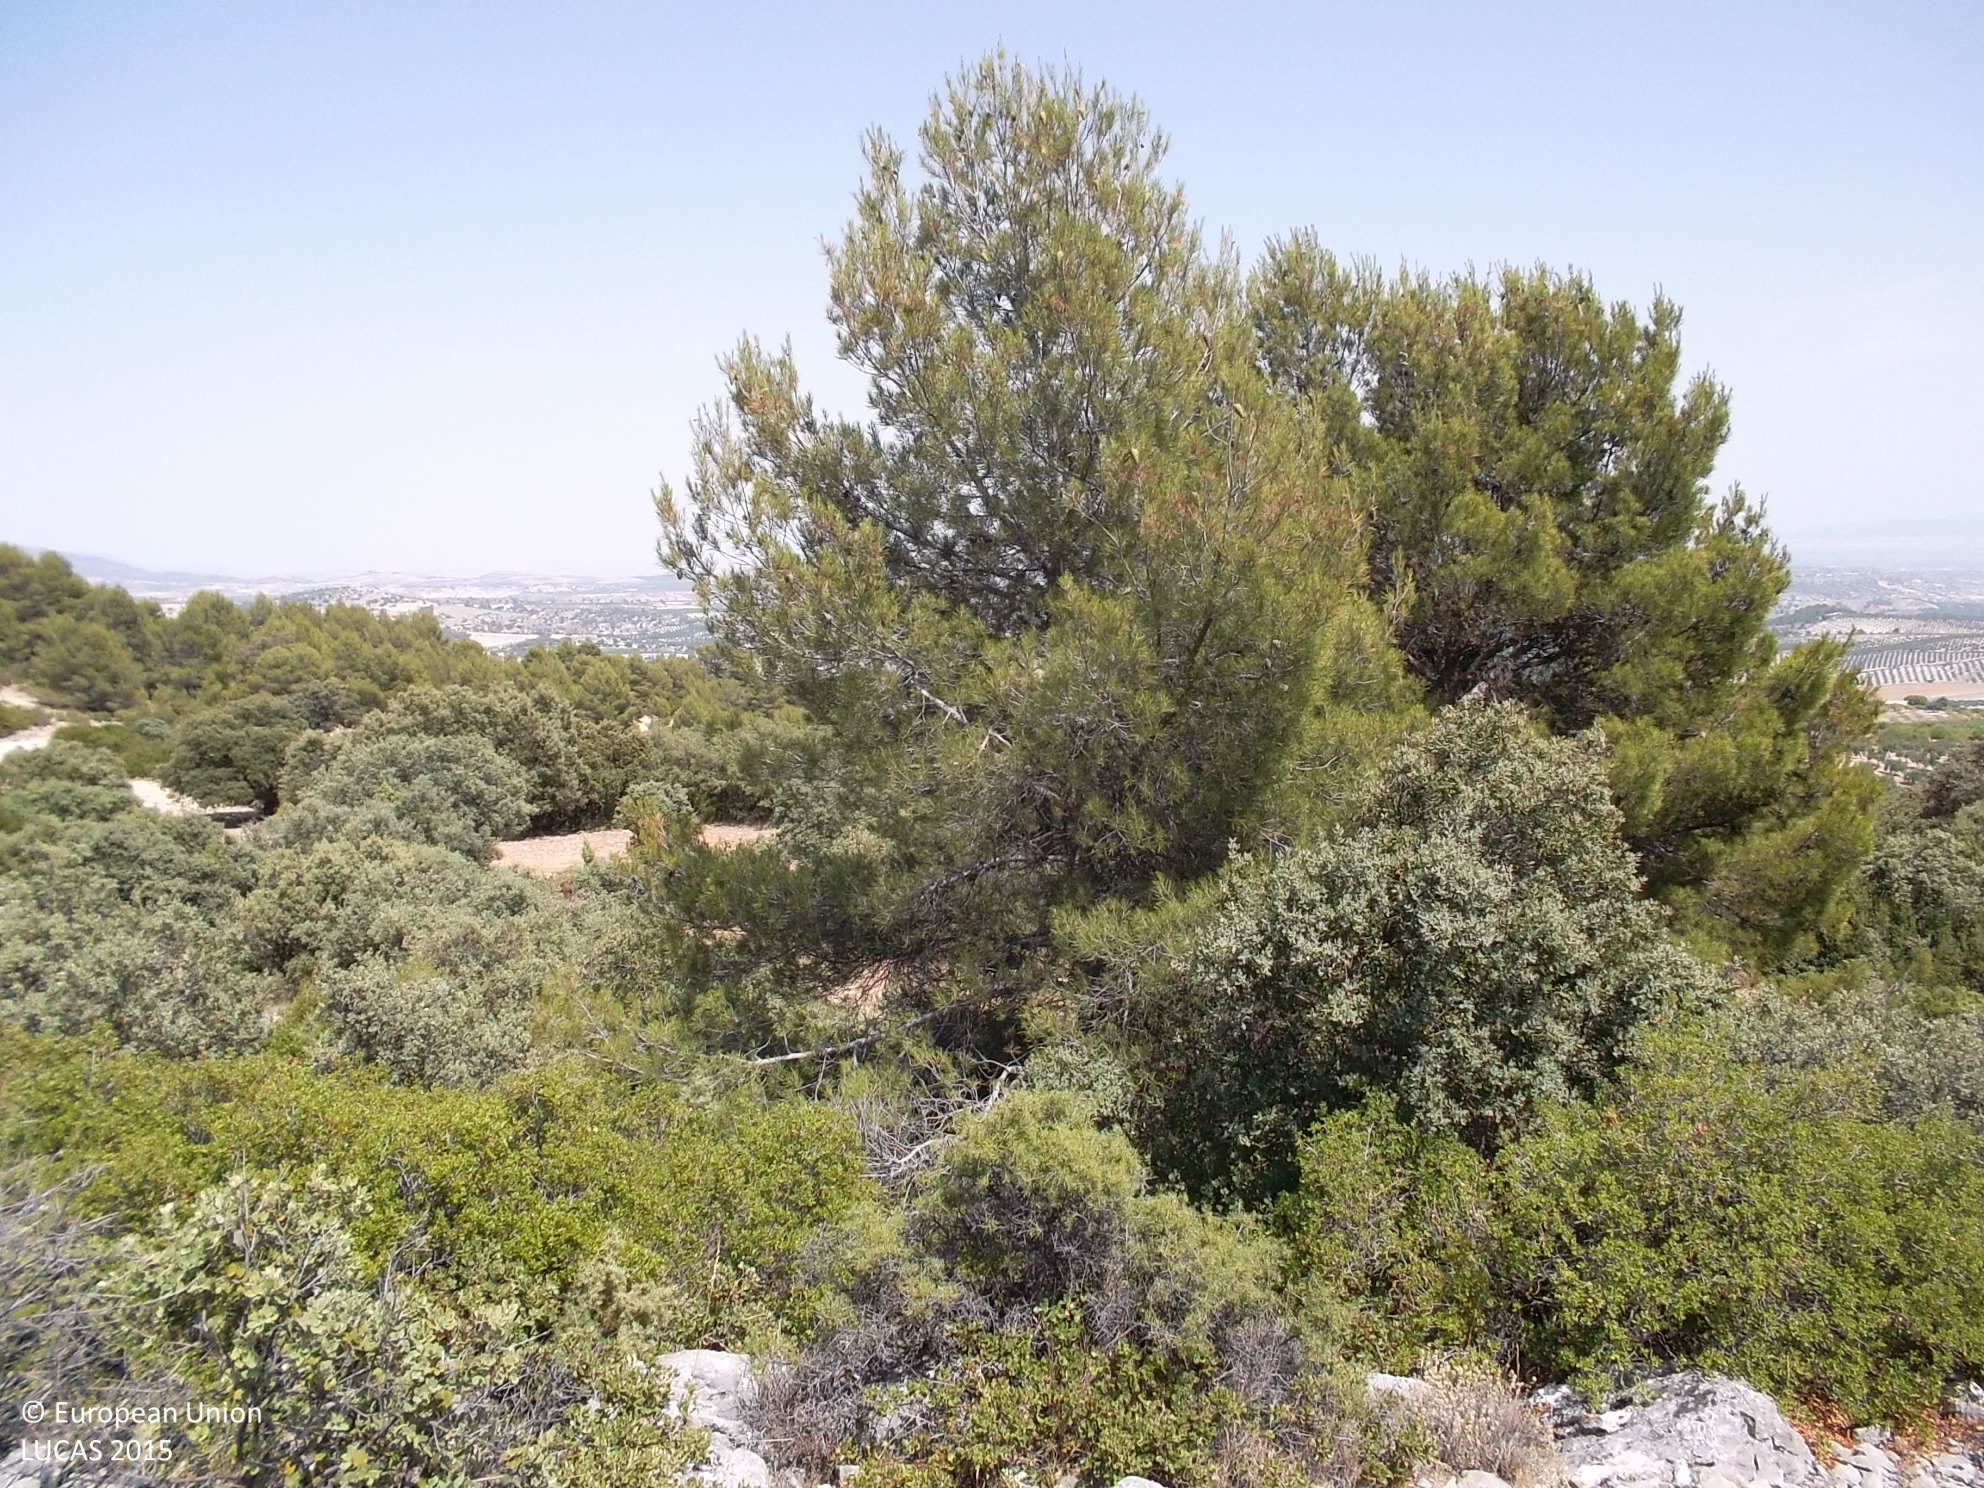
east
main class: Shrubland
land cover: Shrubland with sparse tree cover
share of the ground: 50 - 75 %
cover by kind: consolidated bare surface 60 %, shrubs 35 %, broadleaved forest trees 5 %
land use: Semi-natural and natural areas not in use
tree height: < 5 m
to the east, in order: Shrubland with sparse tree cover; Tracks; Grassland with sparse tree/shrub cover; Rivers and streams; Broadleaved woodland; Lines of trees; Olive groves
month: June
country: ES
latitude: 37.7666
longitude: -2.8765
